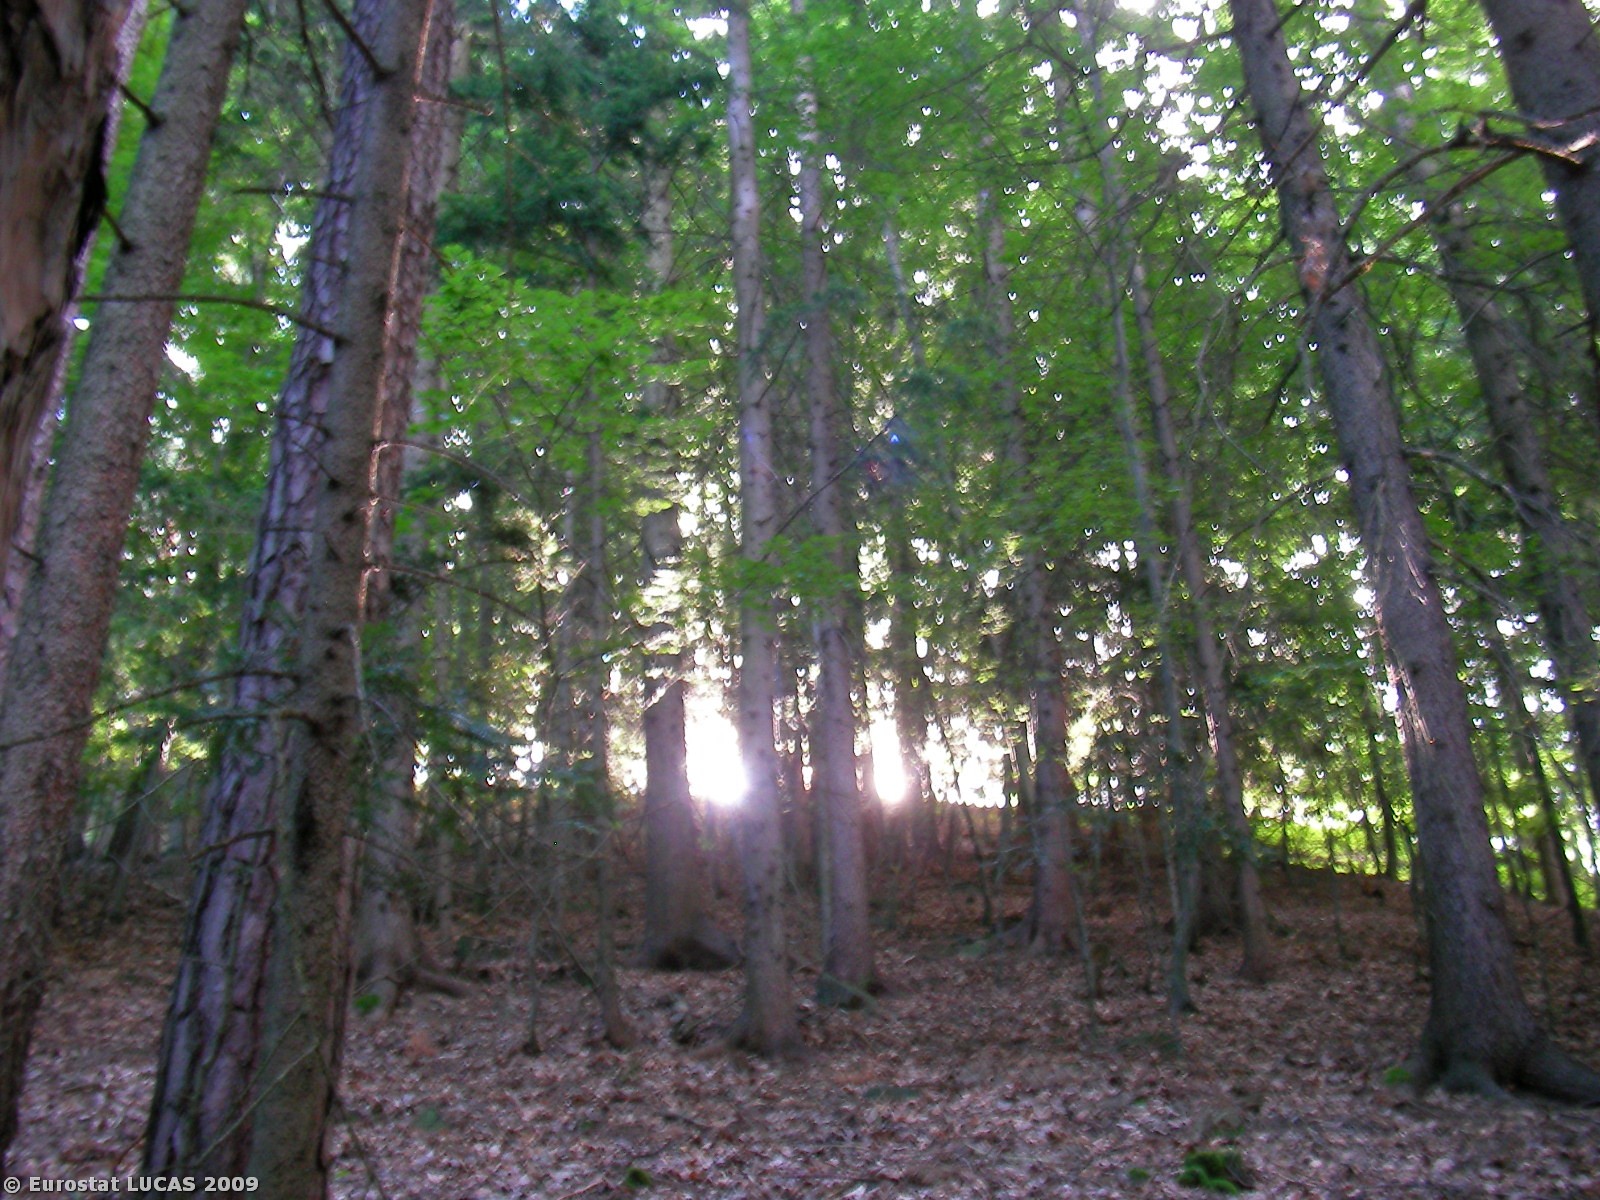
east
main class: Woodland
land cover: Coniferous woodland
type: alpine coniferous forest
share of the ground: > 75 %
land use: Forestry
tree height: > 5 m
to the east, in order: Coniferous woodland; Fences; Grassland without tree/shrub cover; Electric lines; Grassland without tree/shrub cover; Grassland with sparse tree/shrub cover; Artificial constructions in urban areas; Conifer hedges; Grassland without tree/shrub cover; Paved roads, cycling and walking lanes; Grassland without tree/shrub cover; Electric lines; Grassland without tree/shrub cover
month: July
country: AT
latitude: 47.2630
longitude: 15.7234
